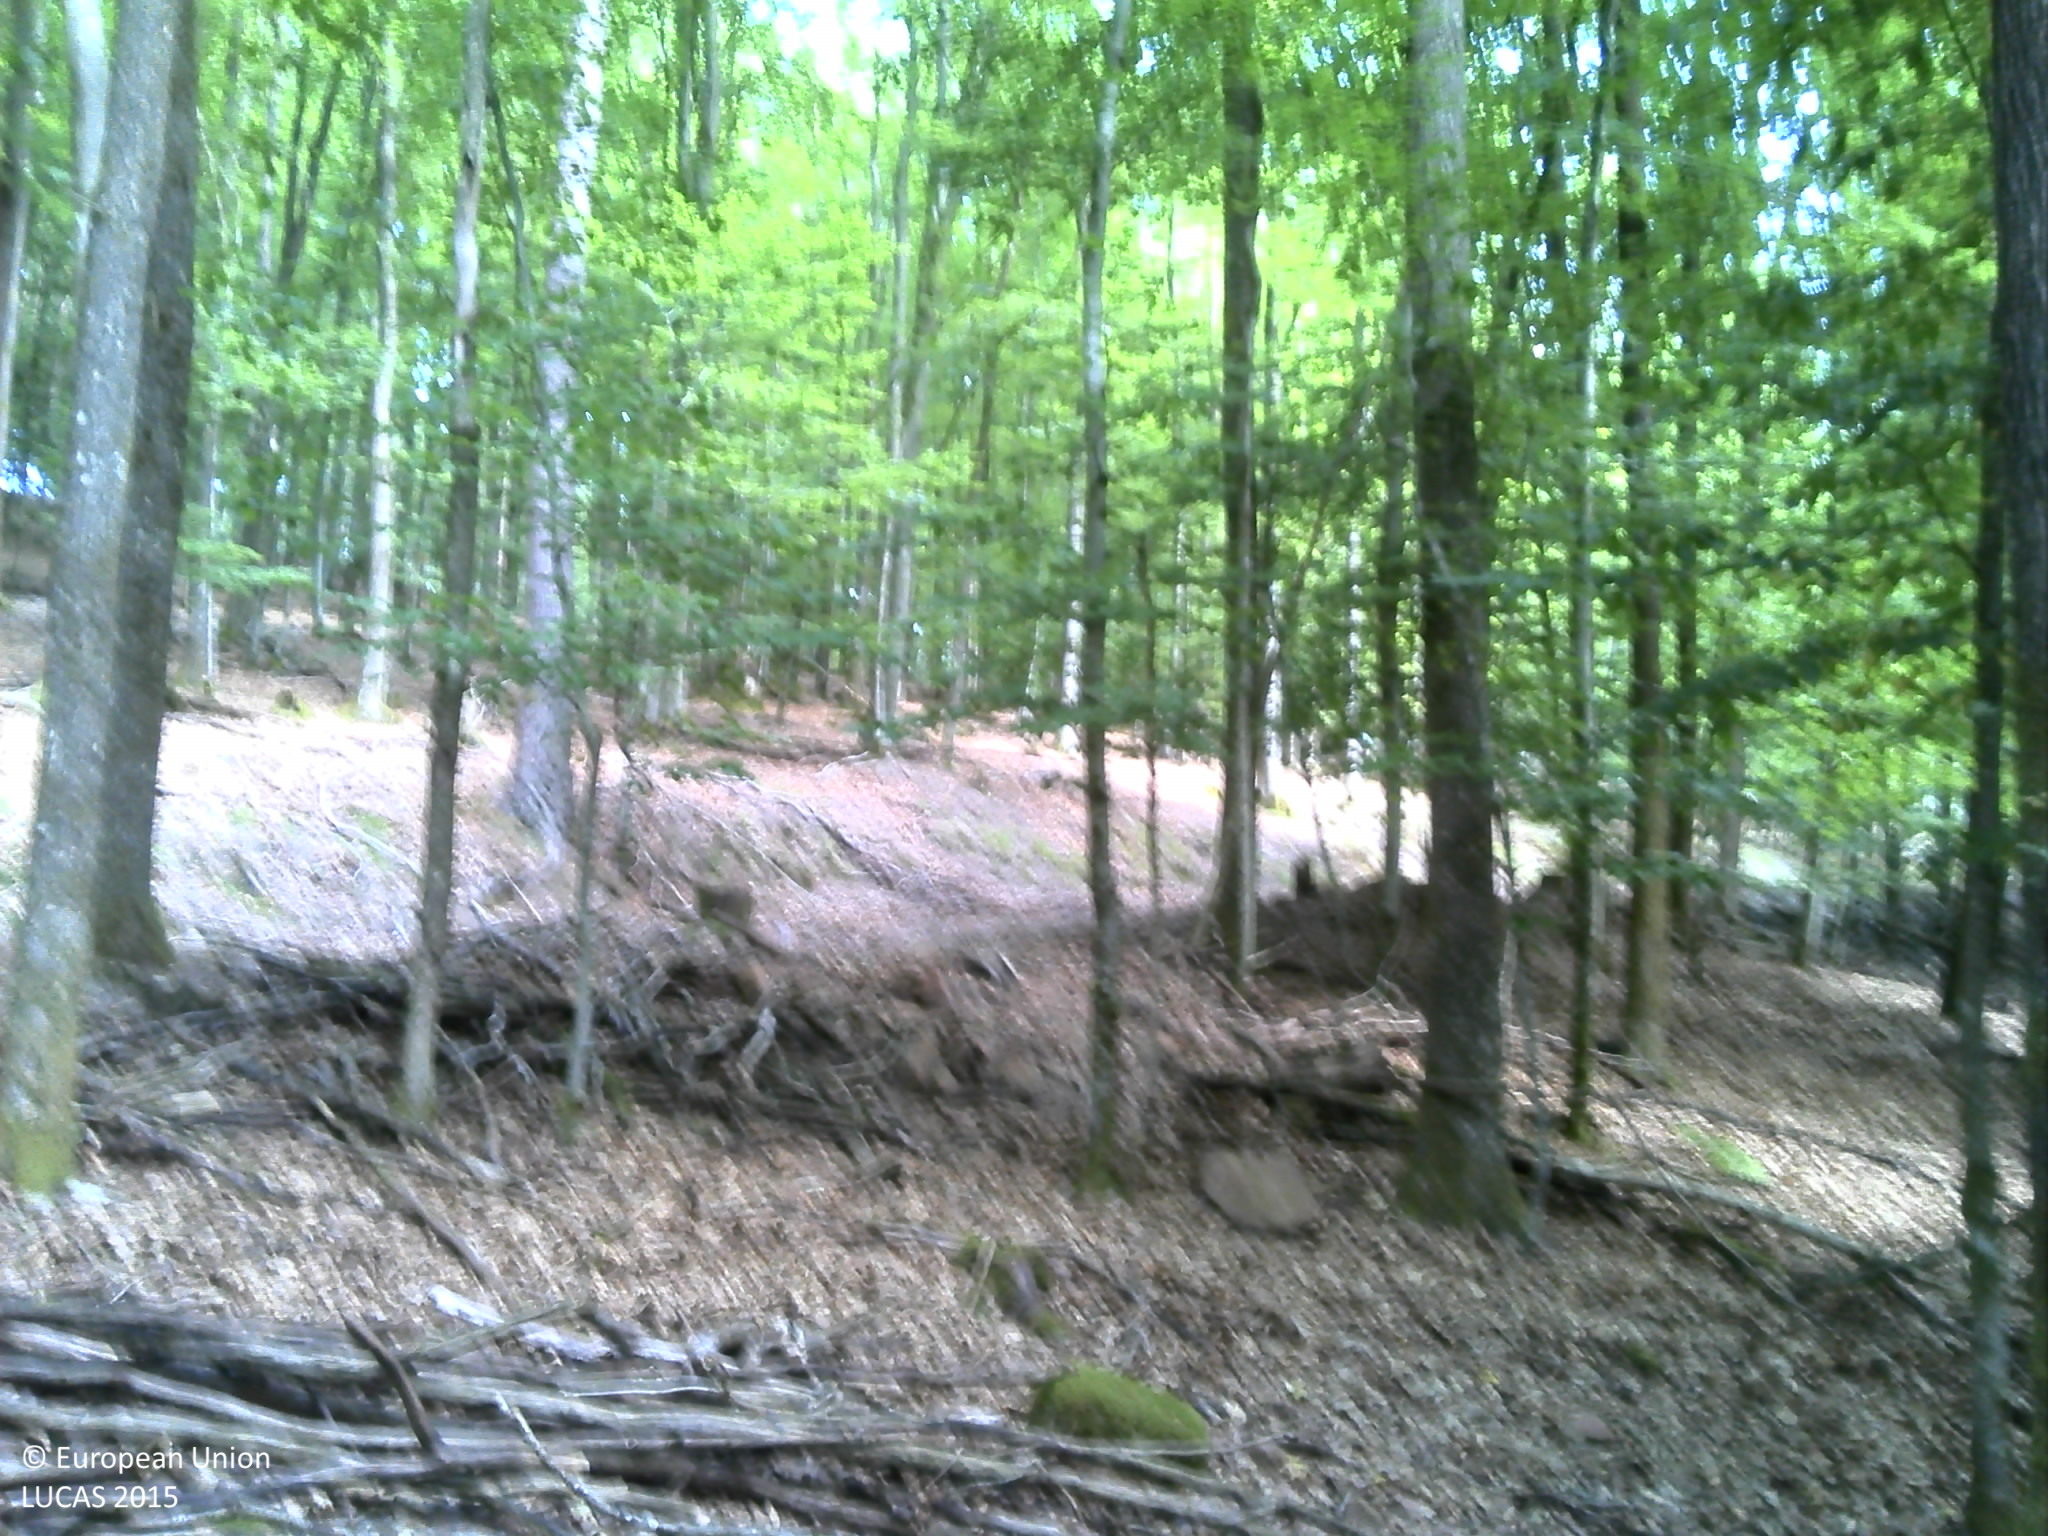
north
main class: Woodland
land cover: Broadleaved woodland
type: acidophilous oak and oak-birch forest
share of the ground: > 75 %
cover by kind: broadleaved forest trees 100 %
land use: Forestry
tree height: > 5 m
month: July
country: FR
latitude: 48.9513
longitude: 7.5017
